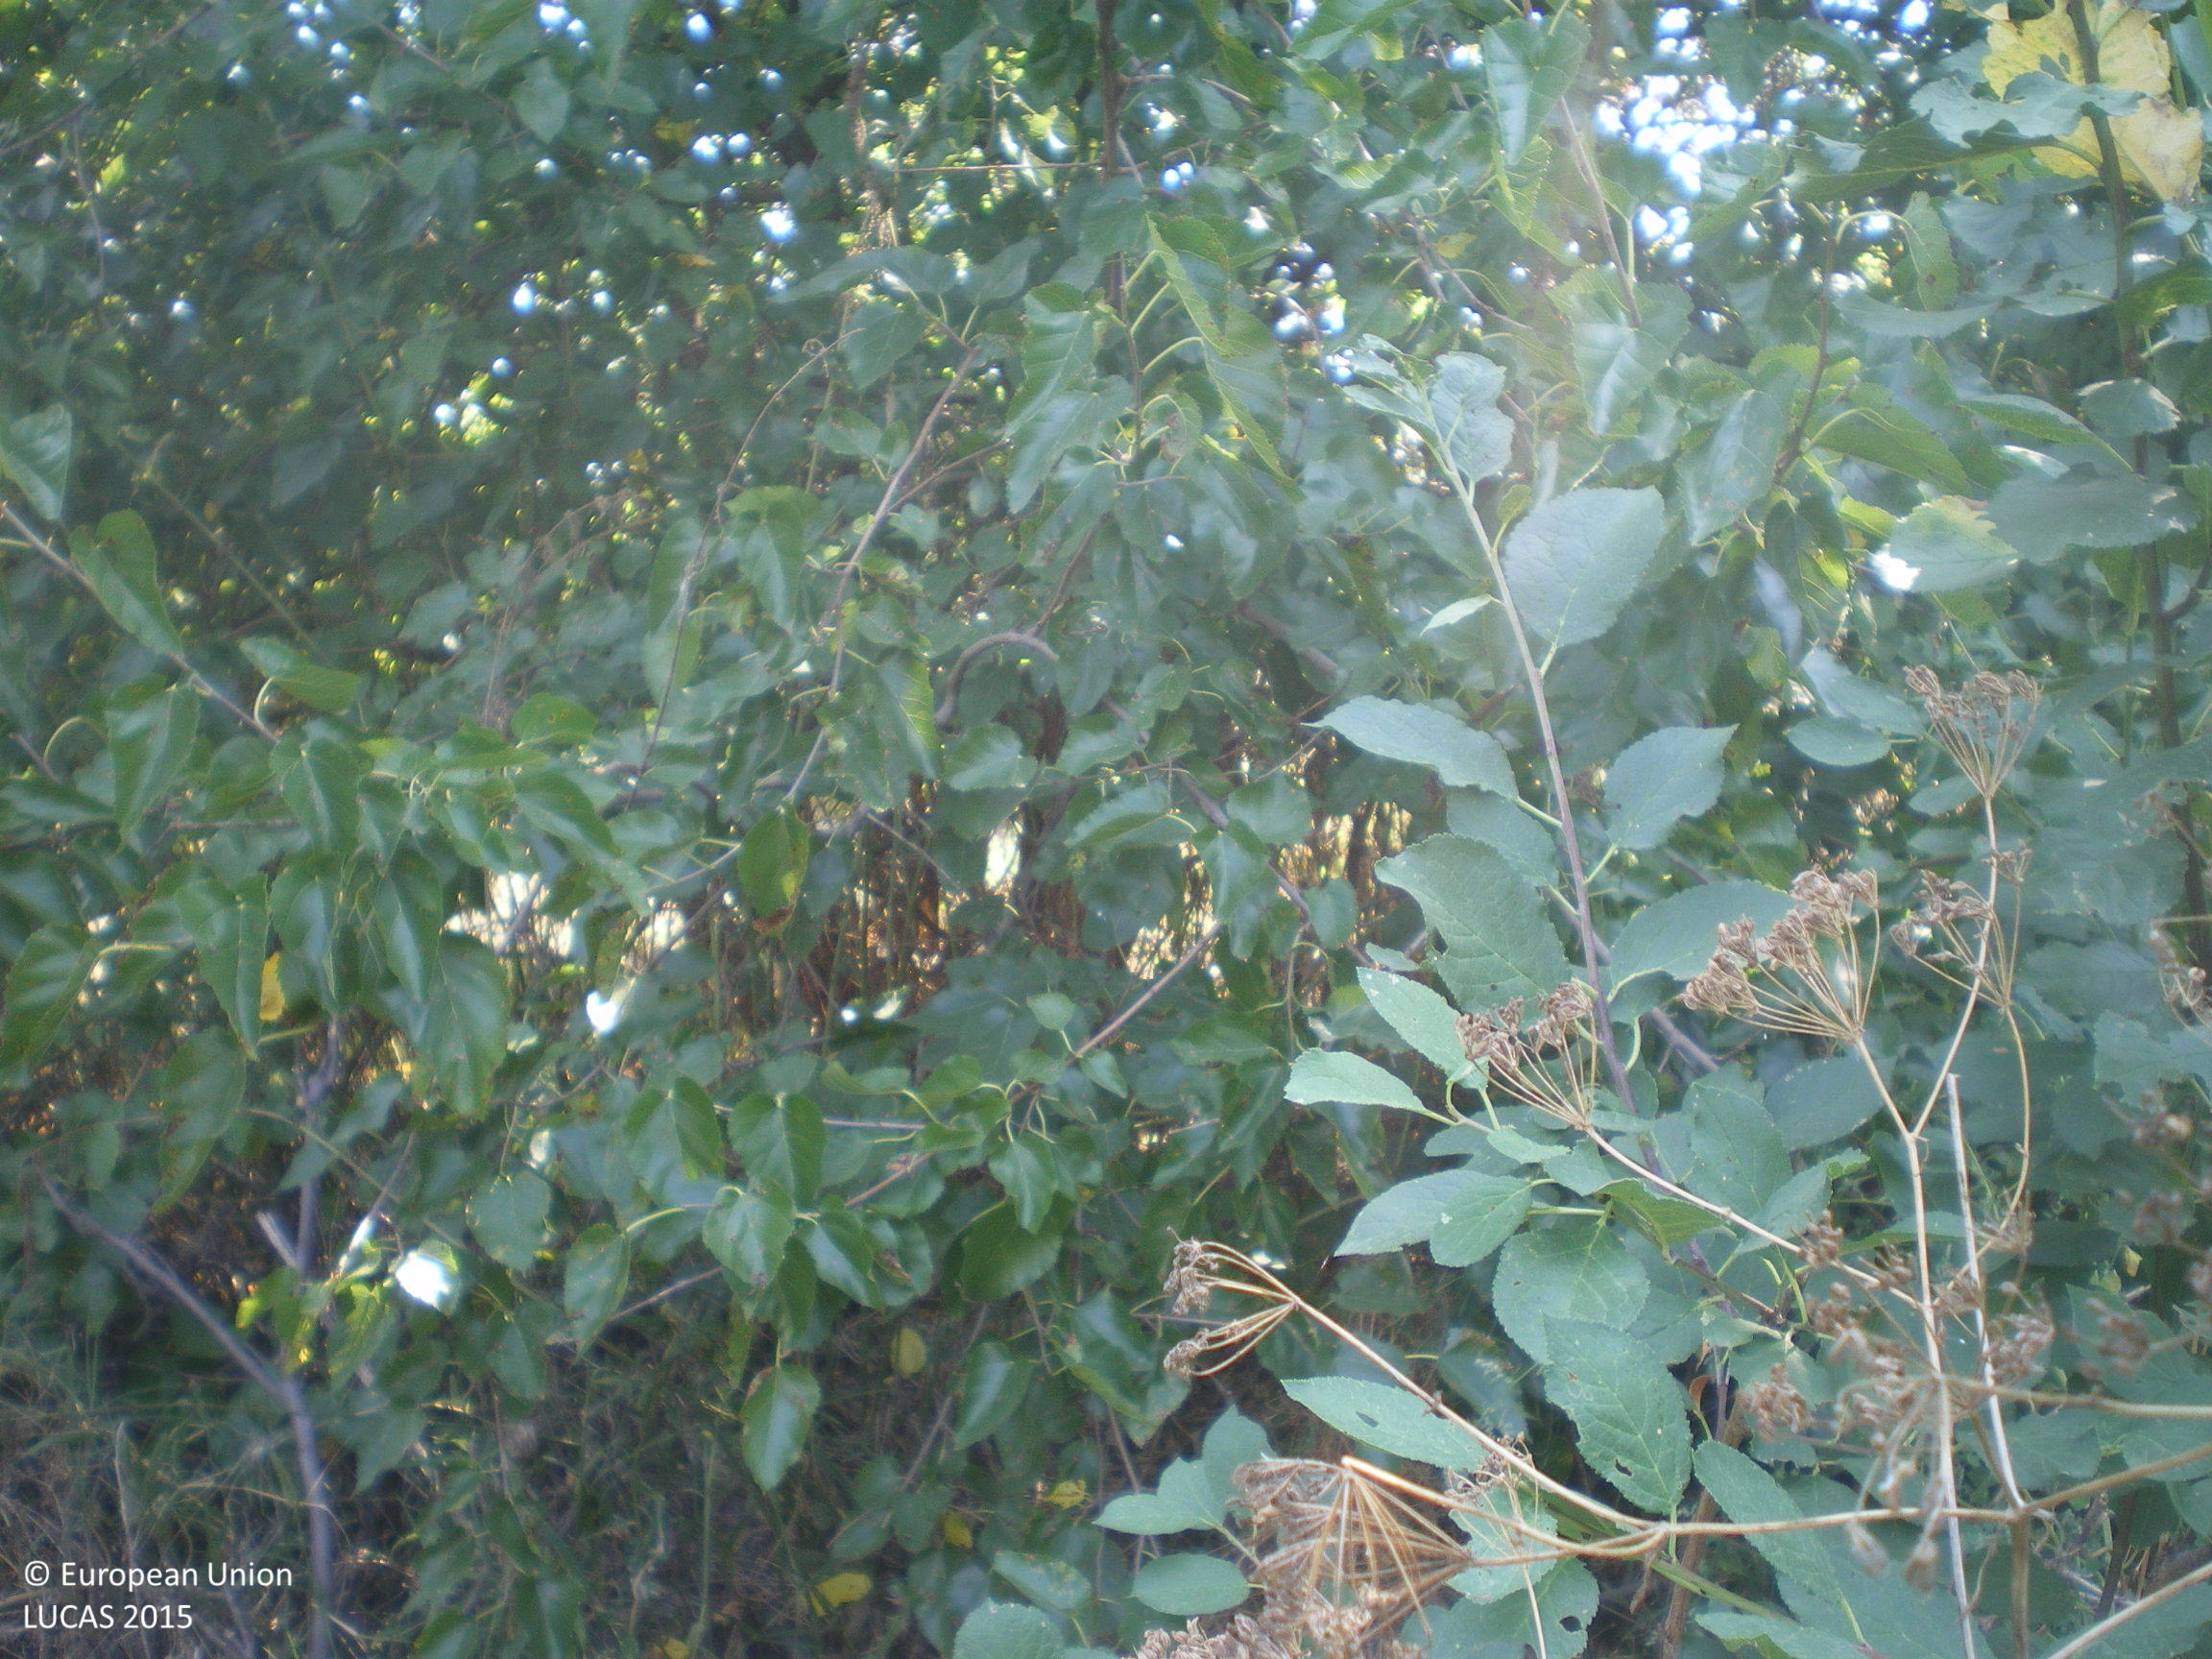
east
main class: Woodland
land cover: Broadleaved woodland
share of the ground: > 75 %
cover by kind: broadleaved forest trees 80 %, shrubs 10 %, herbaceous plants 10 %
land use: Residential
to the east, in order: Broadleaved woodland; Grassland with sparse tree/shrub cover; Artificial constructions in urban areas; Grassland without tree/shrub cover
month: August
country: BG
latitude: 42.3362
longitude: 25.7171
